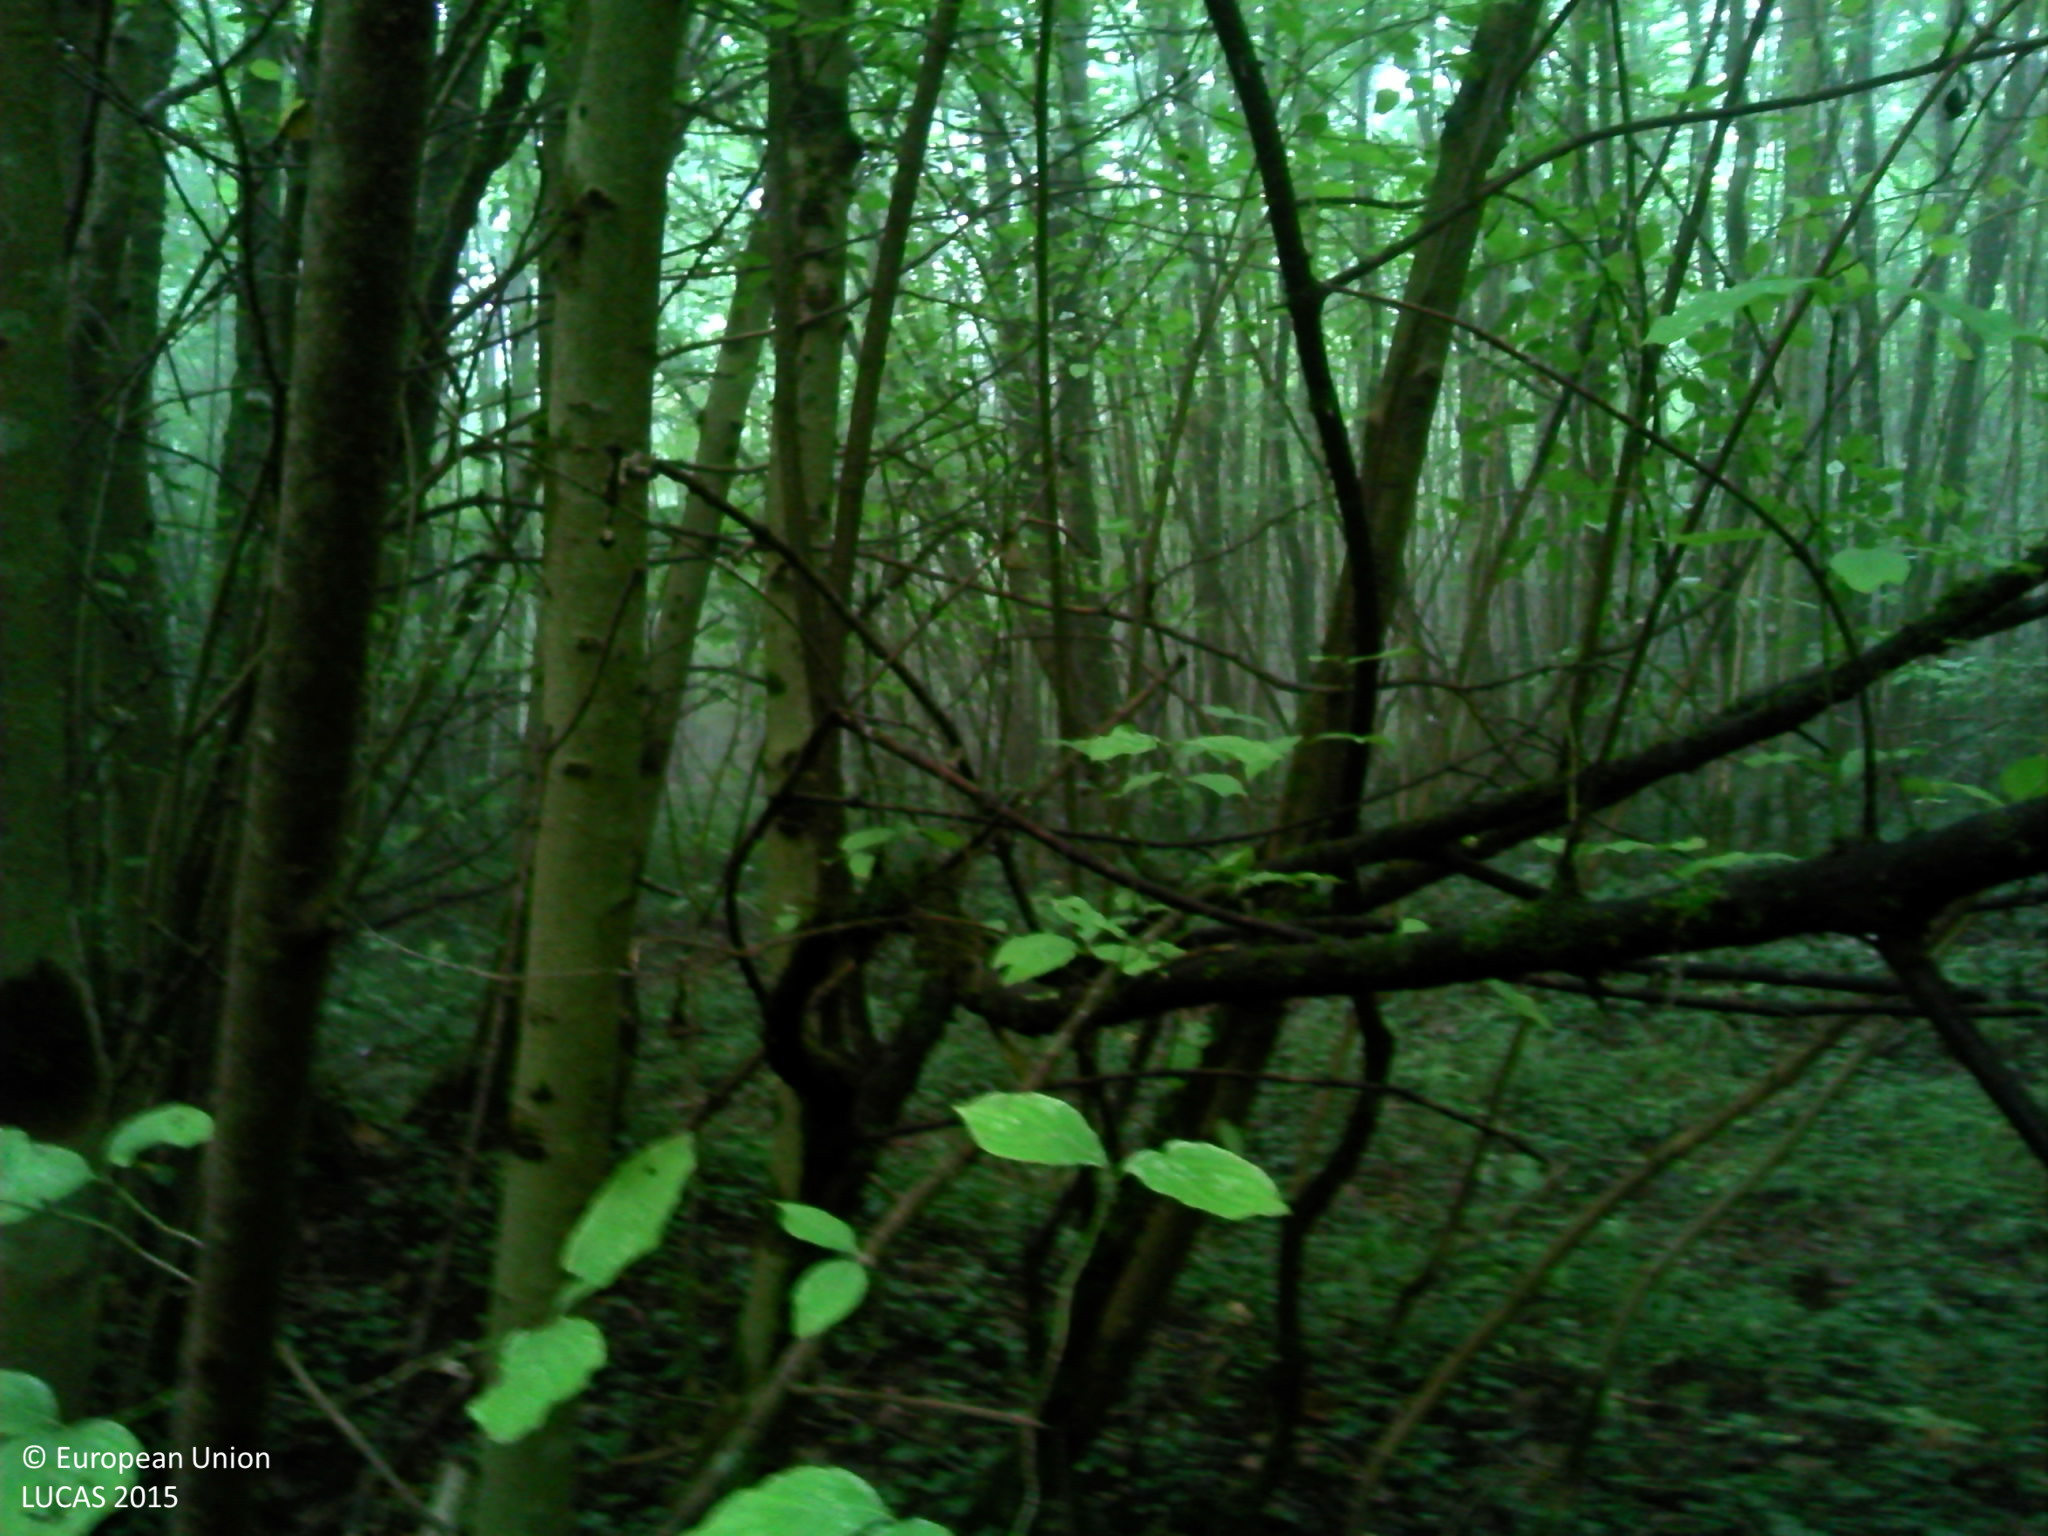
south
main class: Woodland
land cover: Broadleaved woodland
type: mesophytic deciduous forest
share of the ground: > 75 %
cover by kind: broadleaved forest trees 90 %, herbaceous plants 5 %, consolidated bare surface 5 %
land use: Forestry
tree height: > 5 m
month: September
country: FR
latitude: 49.2508
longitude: 6.0291
